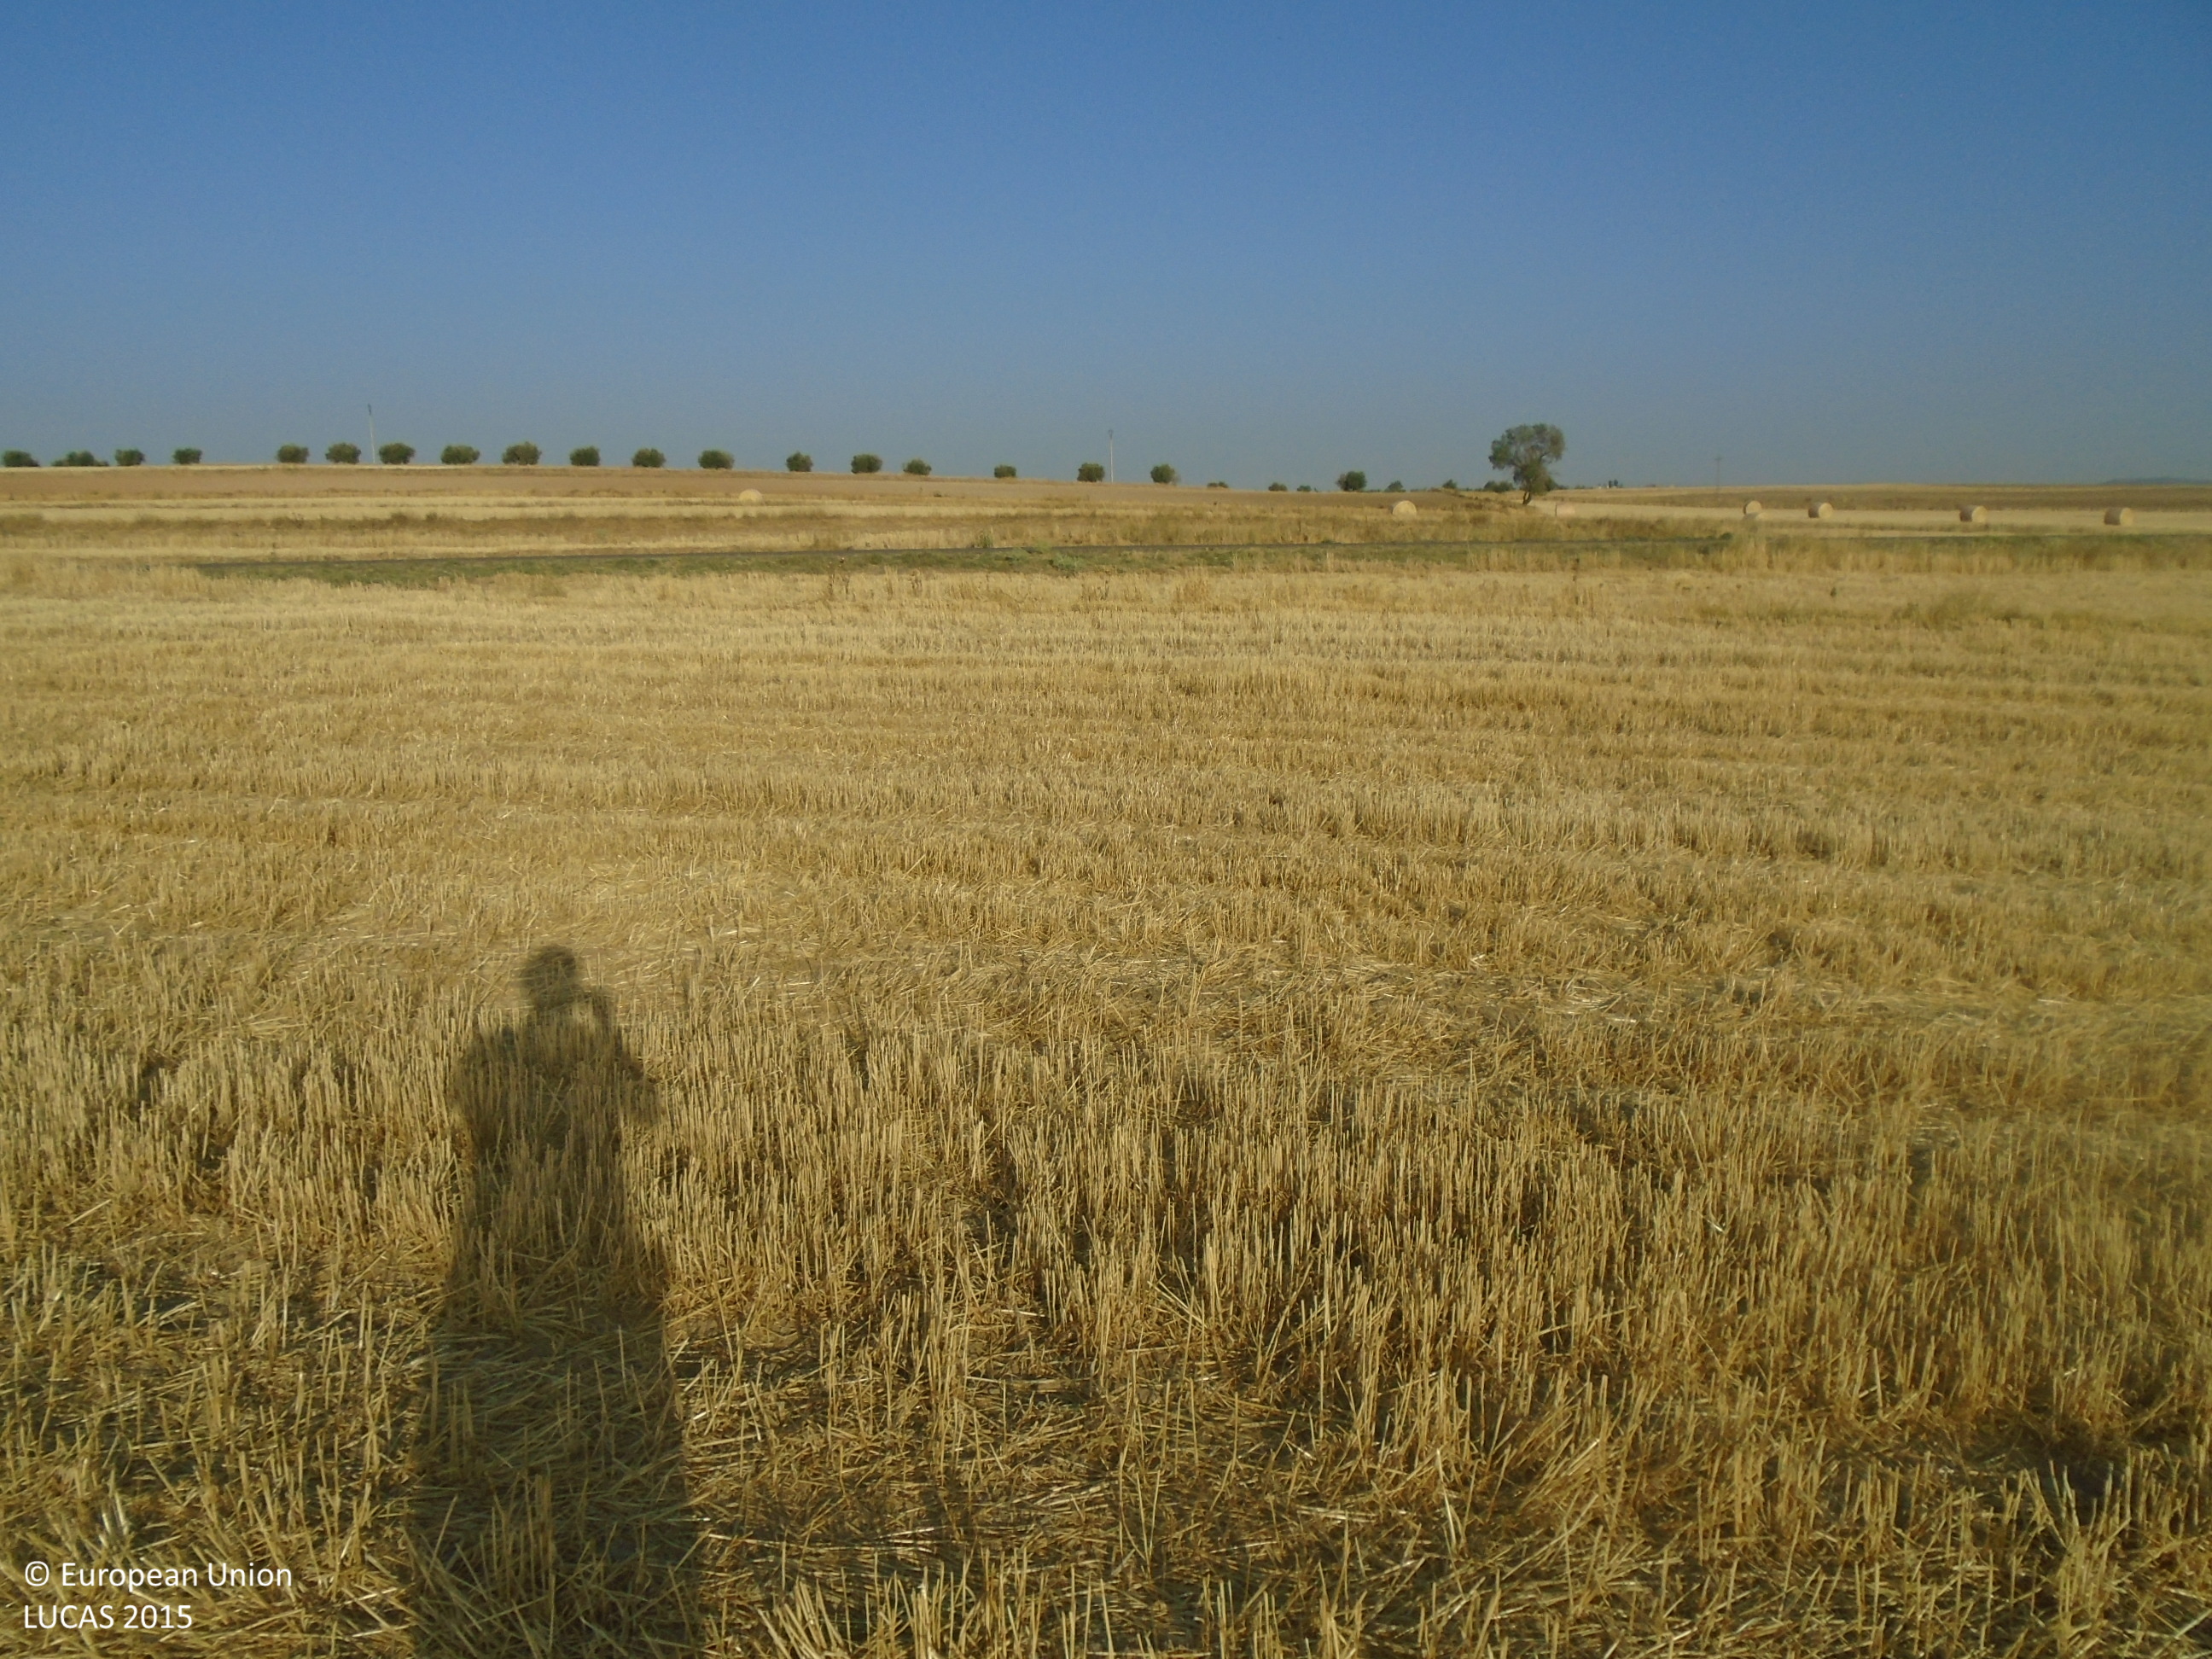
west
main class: Cropland
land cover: Barley
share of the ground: > 75 %
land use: Agriculture (excluding fallow land and kitchen gardens)
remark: Harvested field
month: July
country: ES
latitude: 39.3910
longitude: -3.7129
